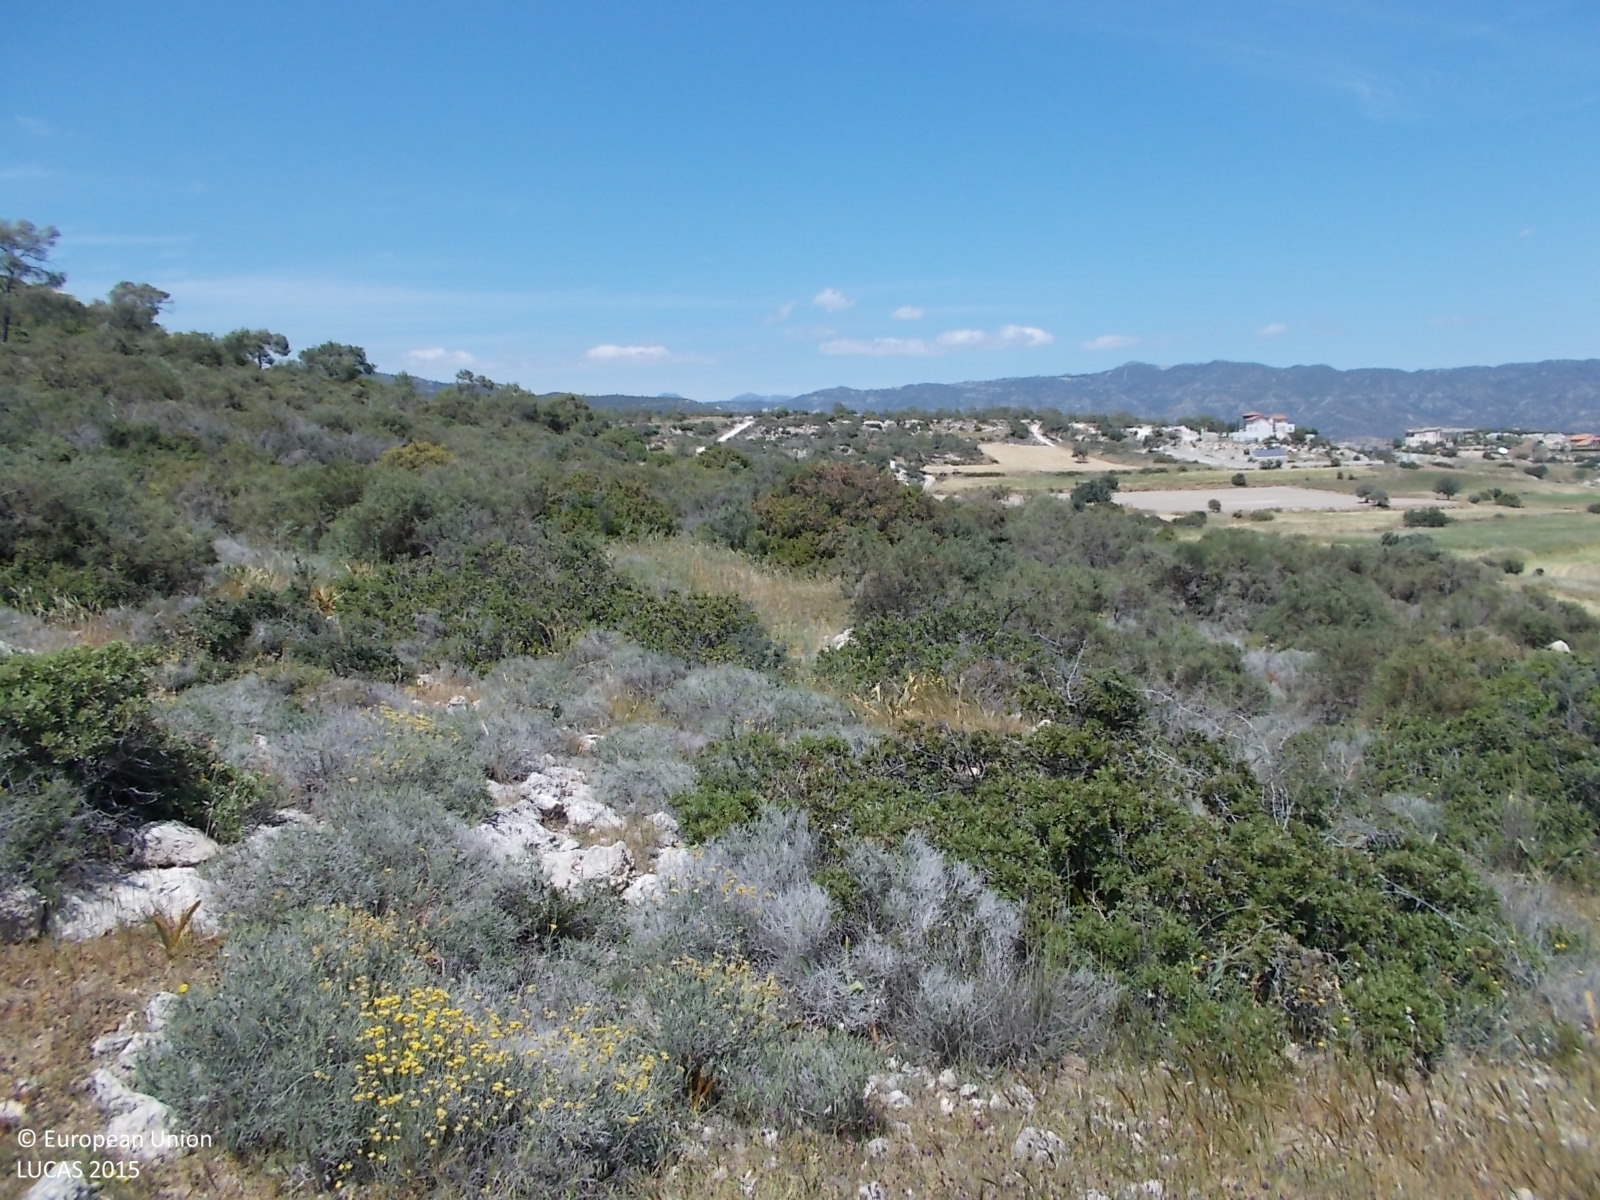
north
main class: Shrubland
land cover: Shrubland with sparse tree cover
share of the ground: > 75 %
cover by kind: shrubs 70 %, herbaceous plants 25 %, broadleaved forest trees 5 %
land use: Semi-natural and natural areas not in use
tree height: < 5 m
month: April
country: CY
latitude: 34.7393
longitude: 33.1400
